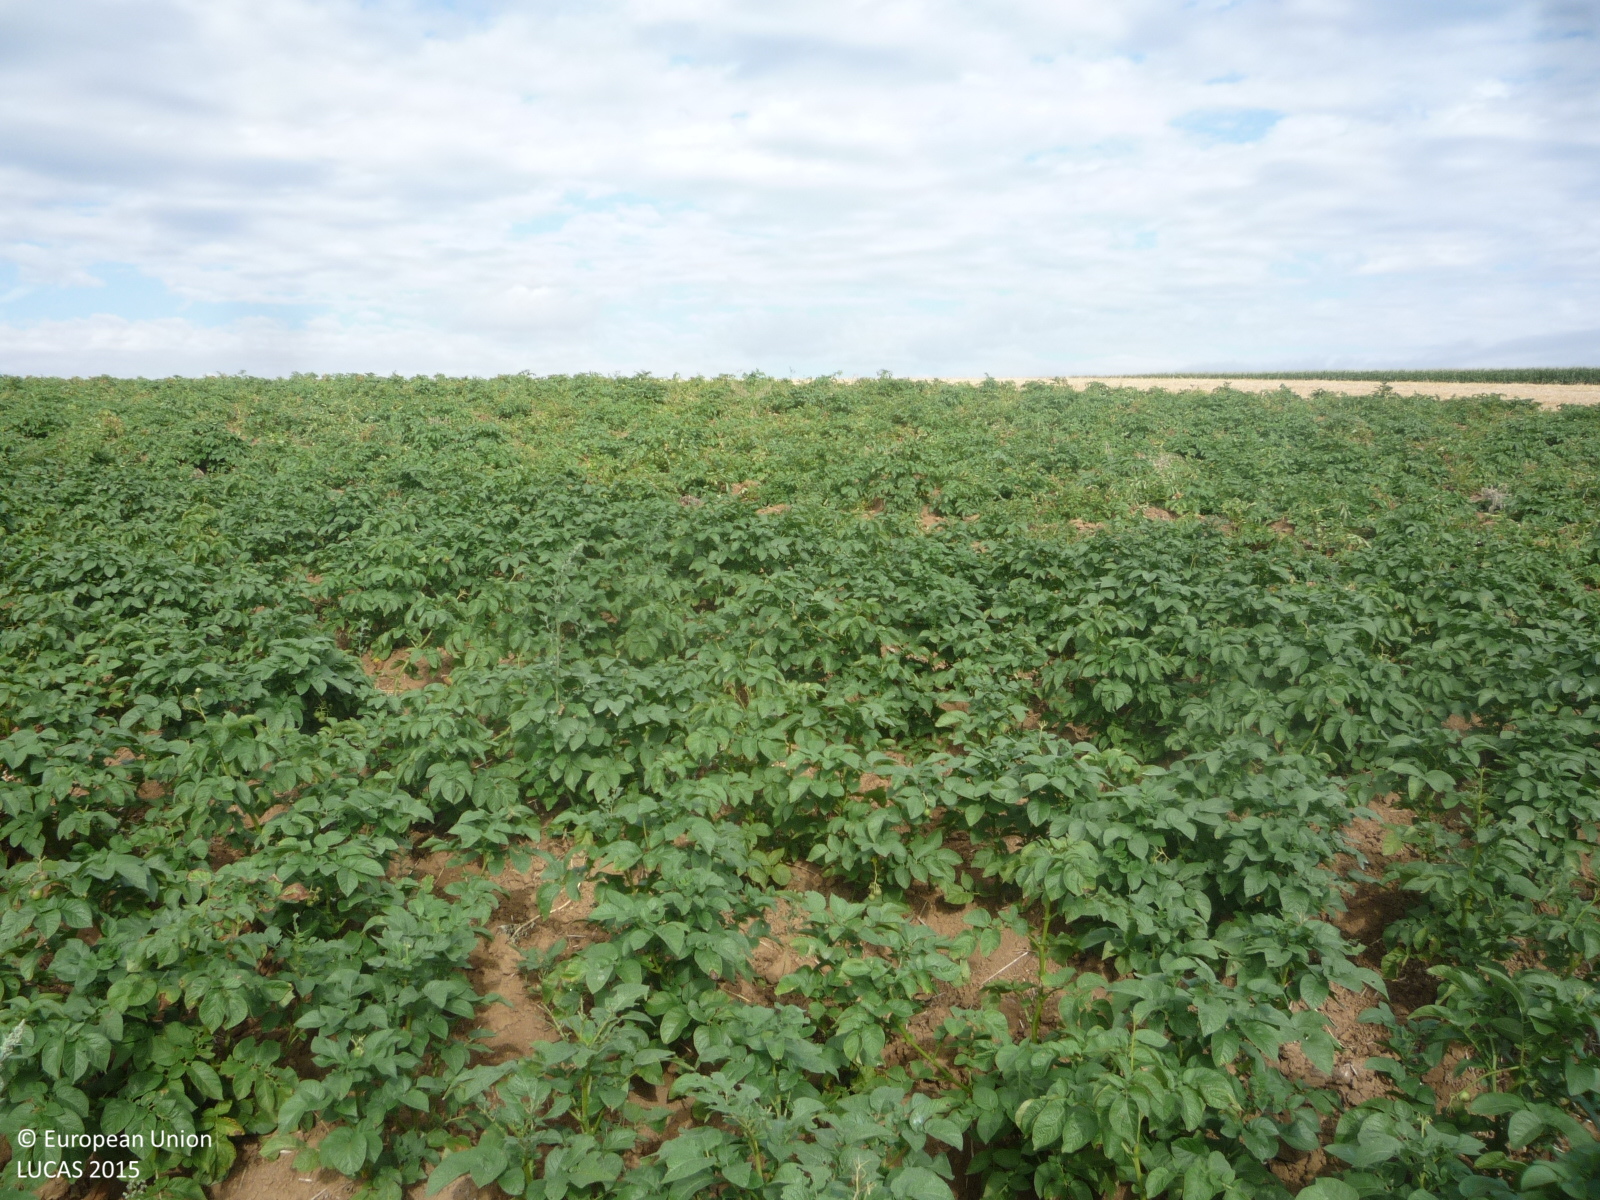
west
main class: Cropland
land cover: Potatoes
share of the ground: > 75 %
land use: Agriculture (excluding fallow land and kitchen gardens)
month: July
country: CZ
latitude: 50.4069
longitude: 15.2236
